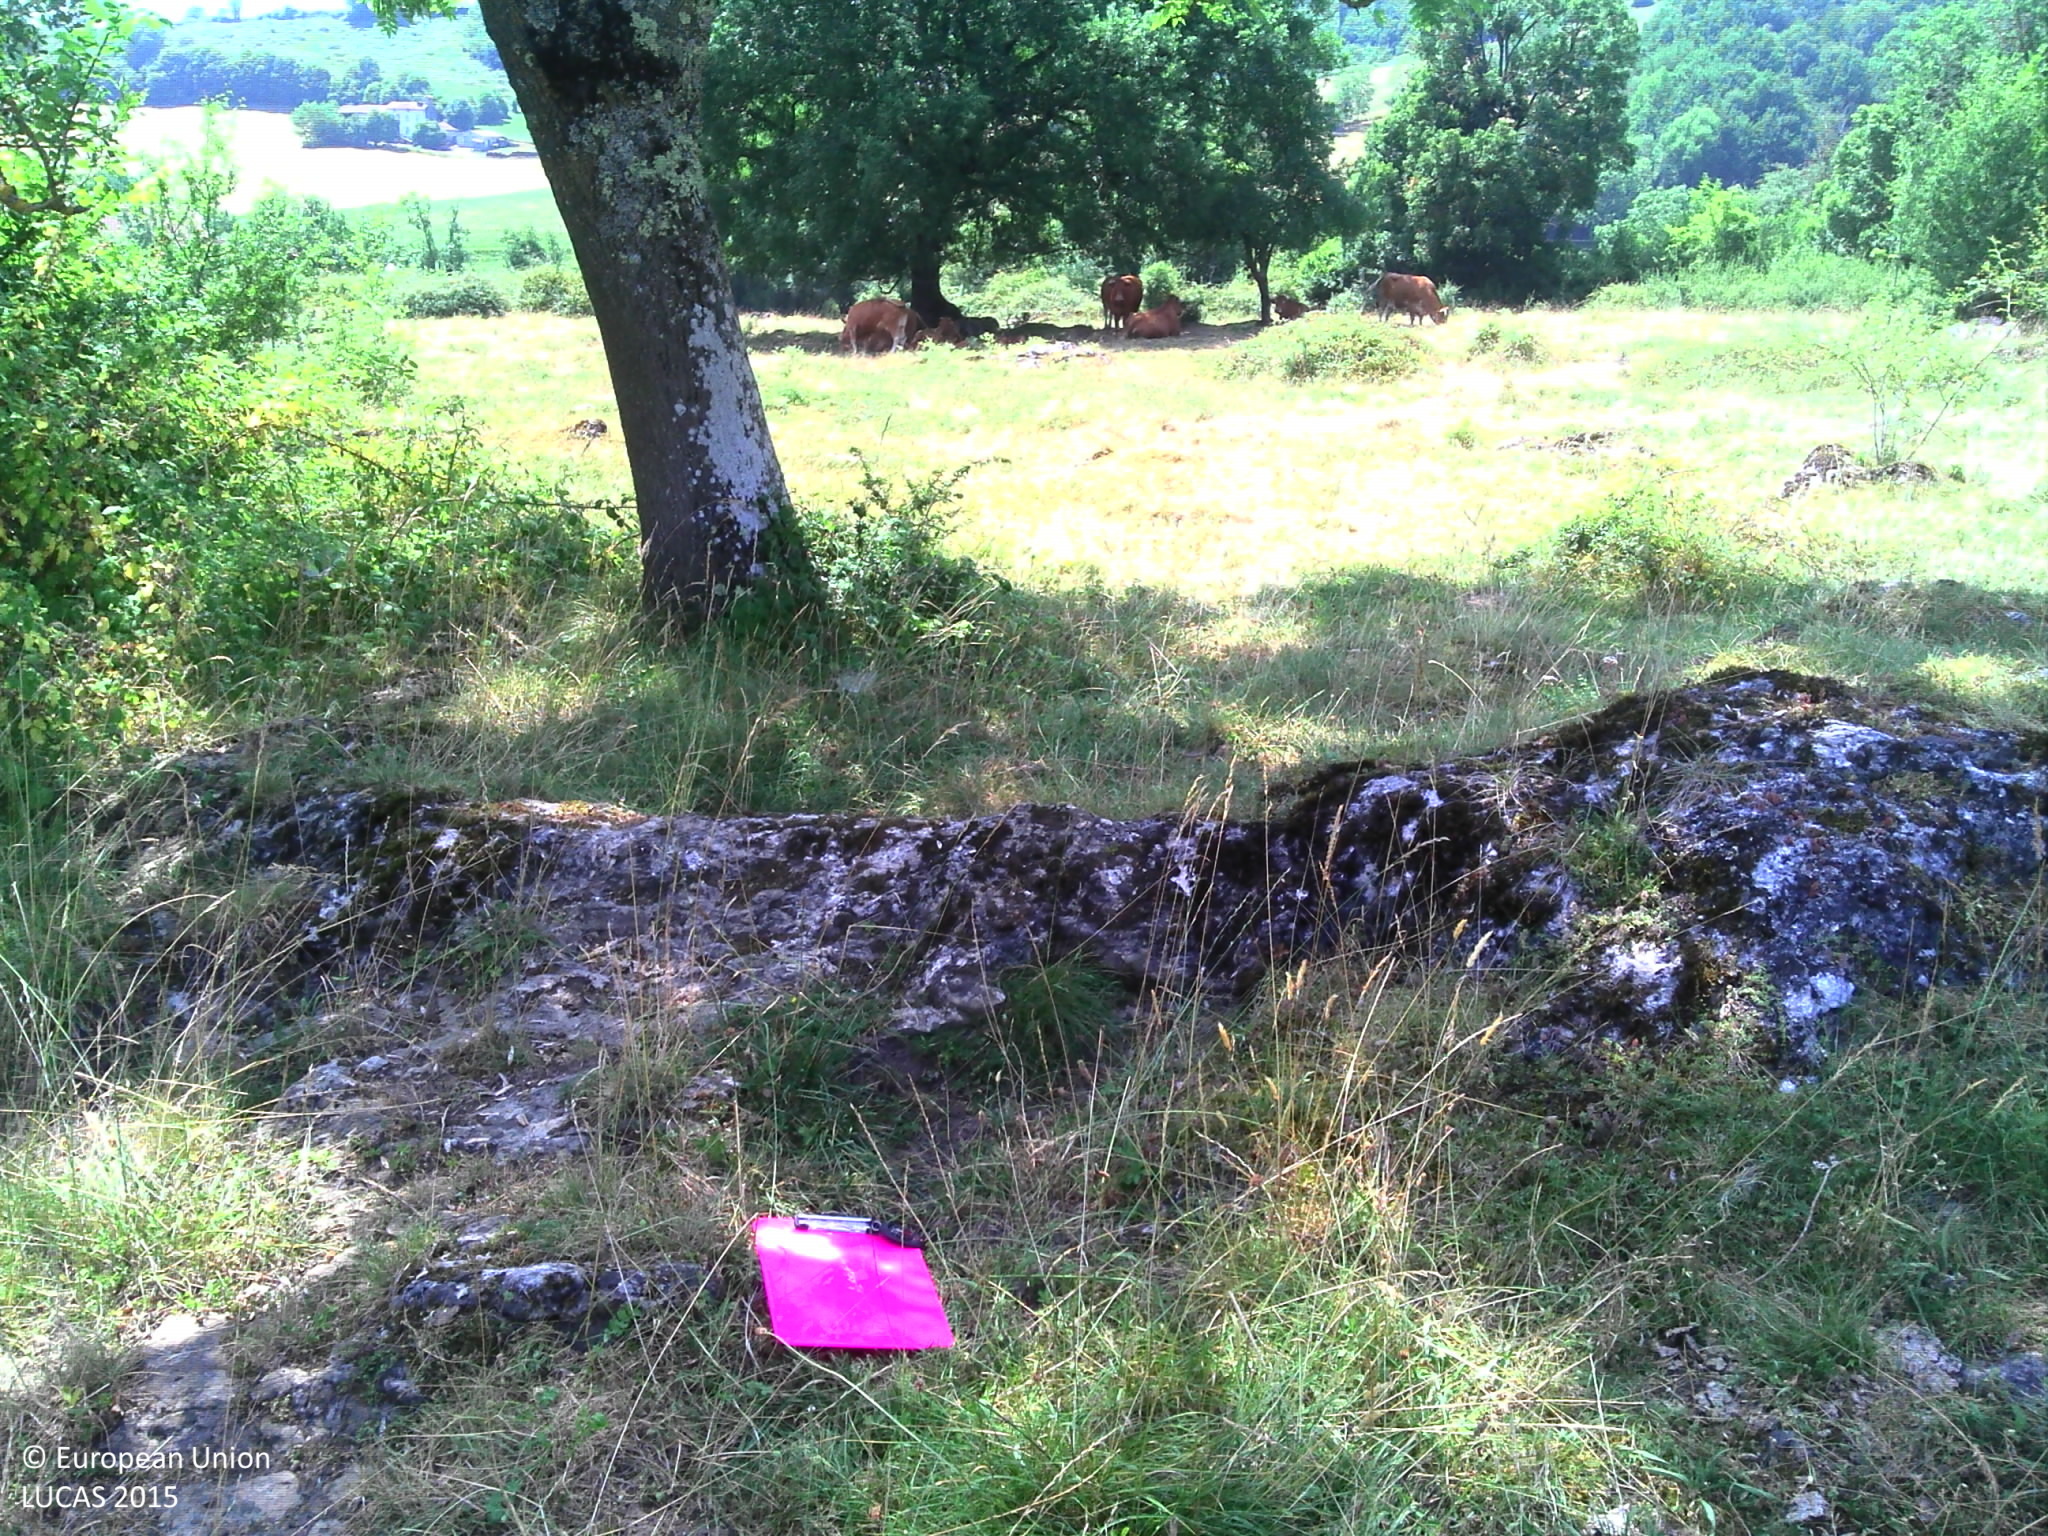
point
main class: Grassland
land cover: Grassland with sparse tree/shrub cover
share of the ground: > 75 %
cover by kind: herbaceous plants 85 %, shrubs 10 %, broadleaved forest trees 5 %
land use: Agriculture (excluding fallow land and kitchen gardens)
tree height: > 5 m
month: July
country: FR
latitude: 43.0110
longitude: 1.1588
